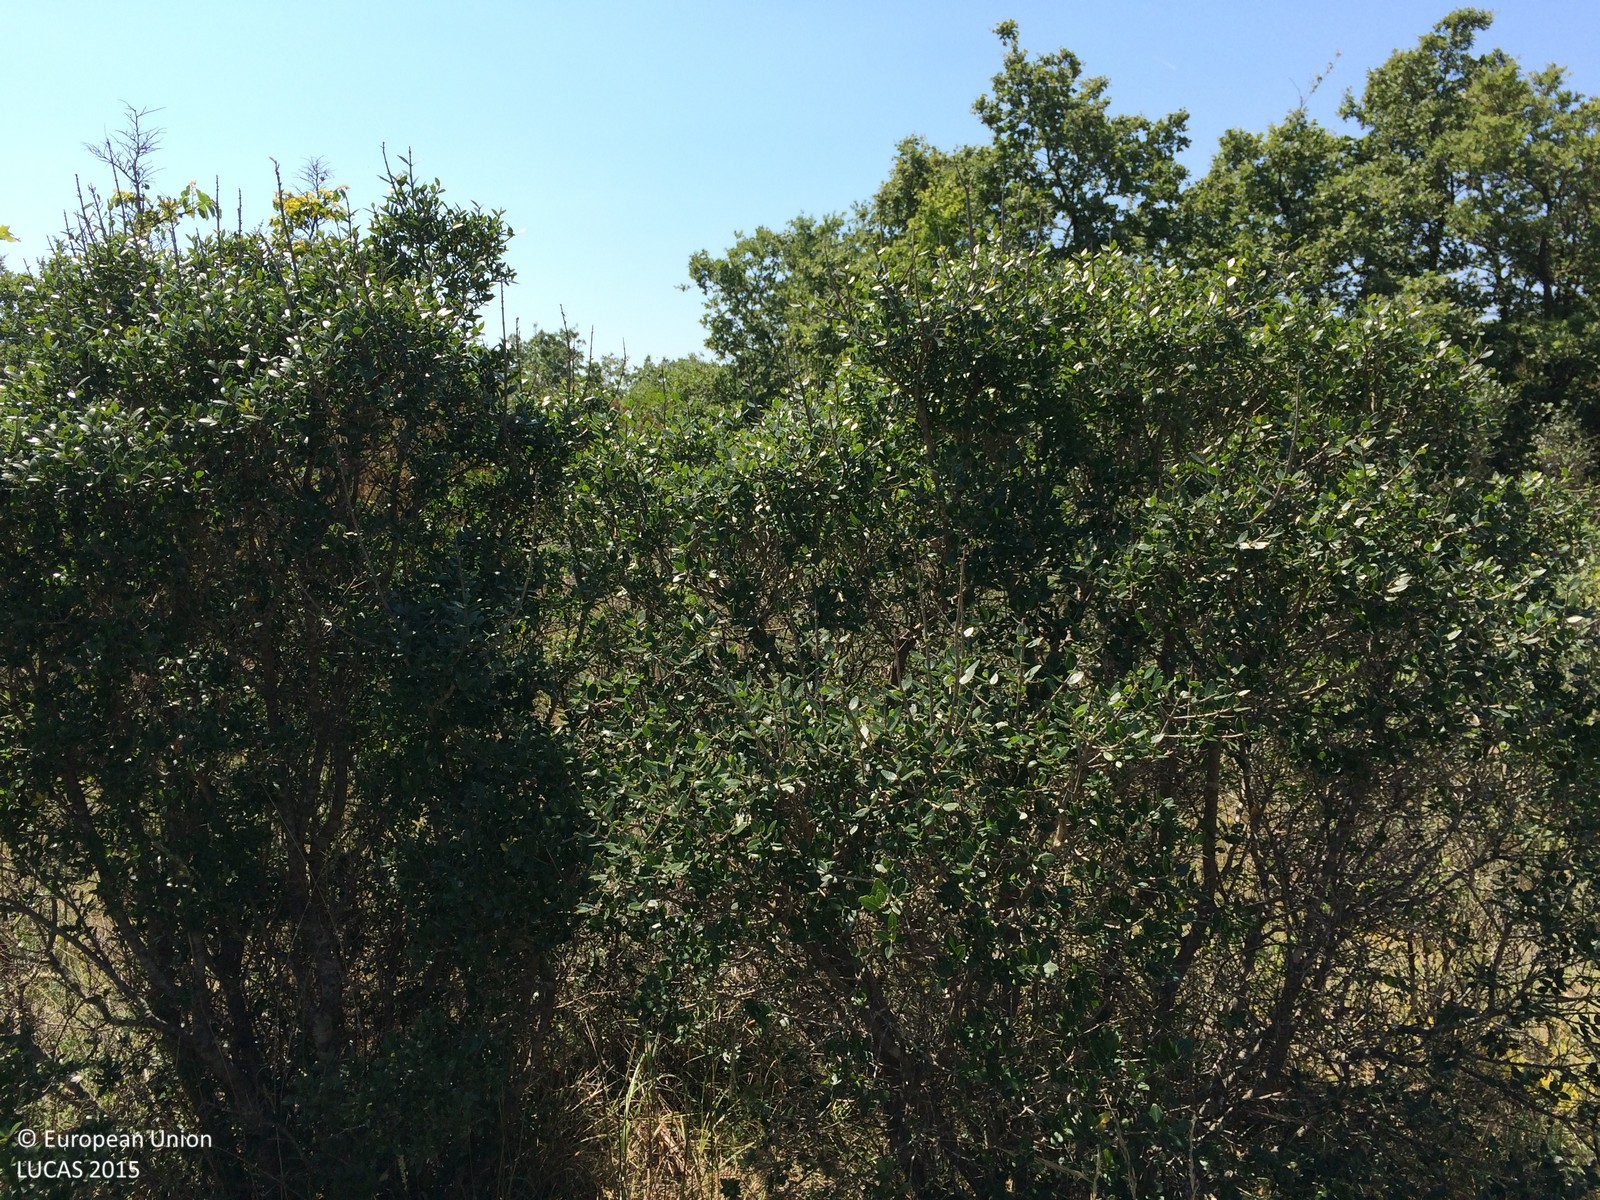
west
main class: Shrubland
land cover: Shrubland with sparse tree cover
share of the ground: > 75 %
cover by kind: shrubs 90 %, broadleaved forest trees 5 %, herbaceous plants 5 %
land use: Semi-natural and natural areas not in use
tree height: < 5 m
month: June
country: HR
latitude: 45.0025
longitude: 13.8130
